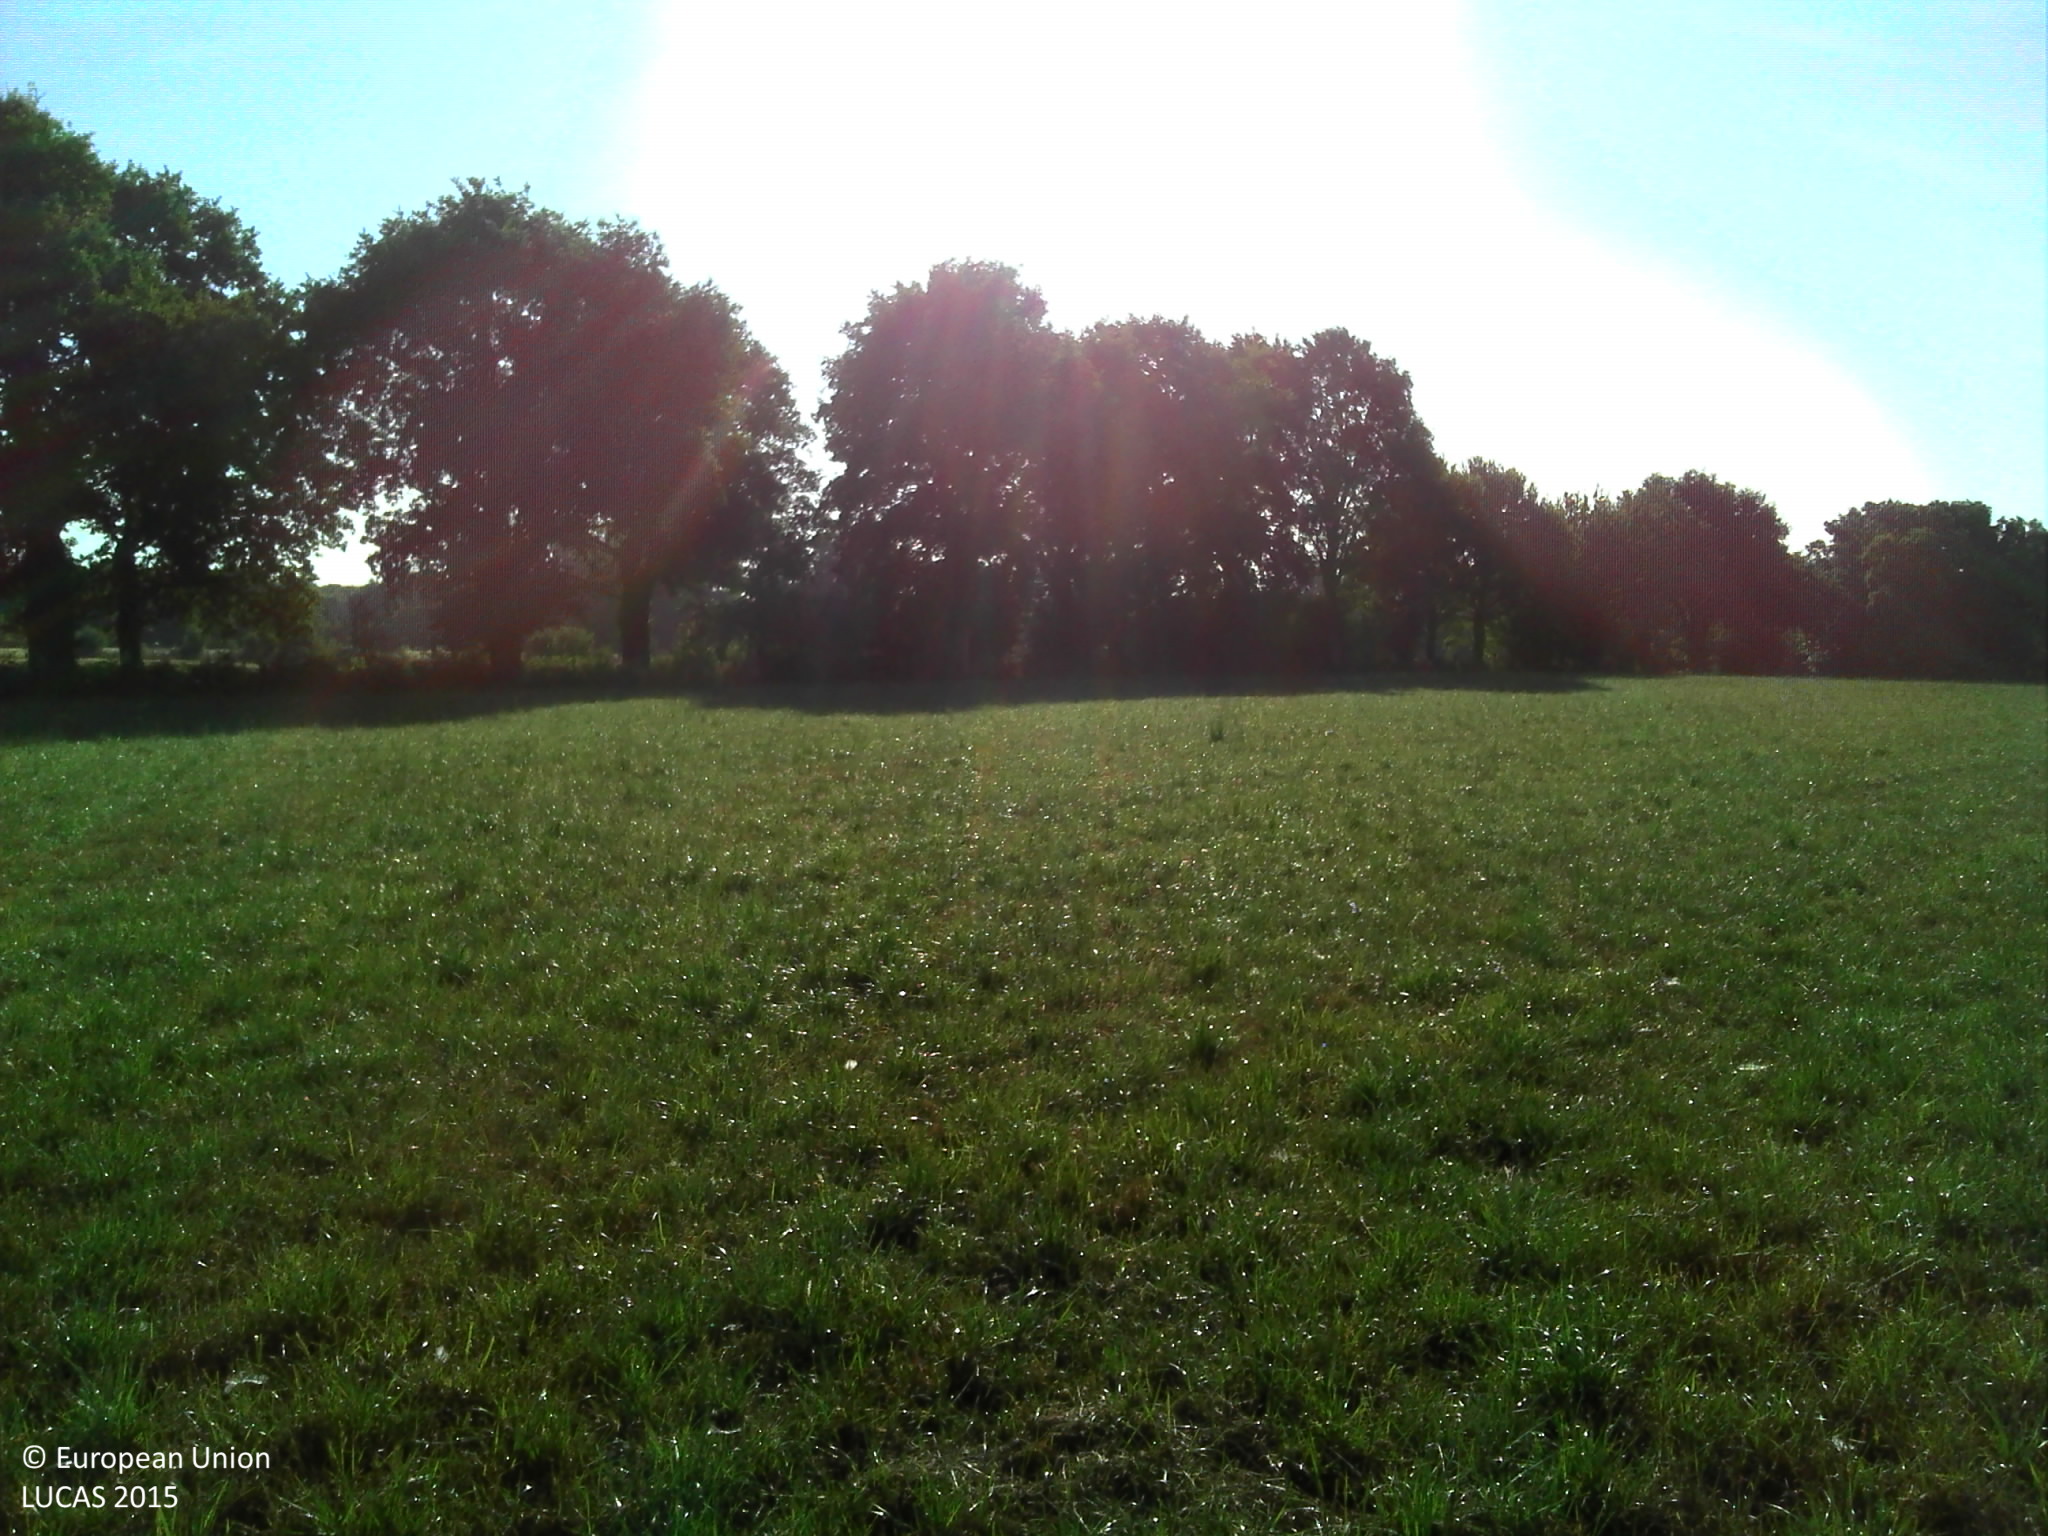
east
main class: Cropland
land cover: Temporary grasslands
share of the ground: > 75 %
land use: Agriculture (excluding fallow land and kitchen gardens)
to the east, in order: Temporary grasslands; Fences; Broadleaved woodland; Tracks; Broadleaved woodland; Common wheat
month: July
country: FR
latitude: 47.6261
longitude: -1.6086
